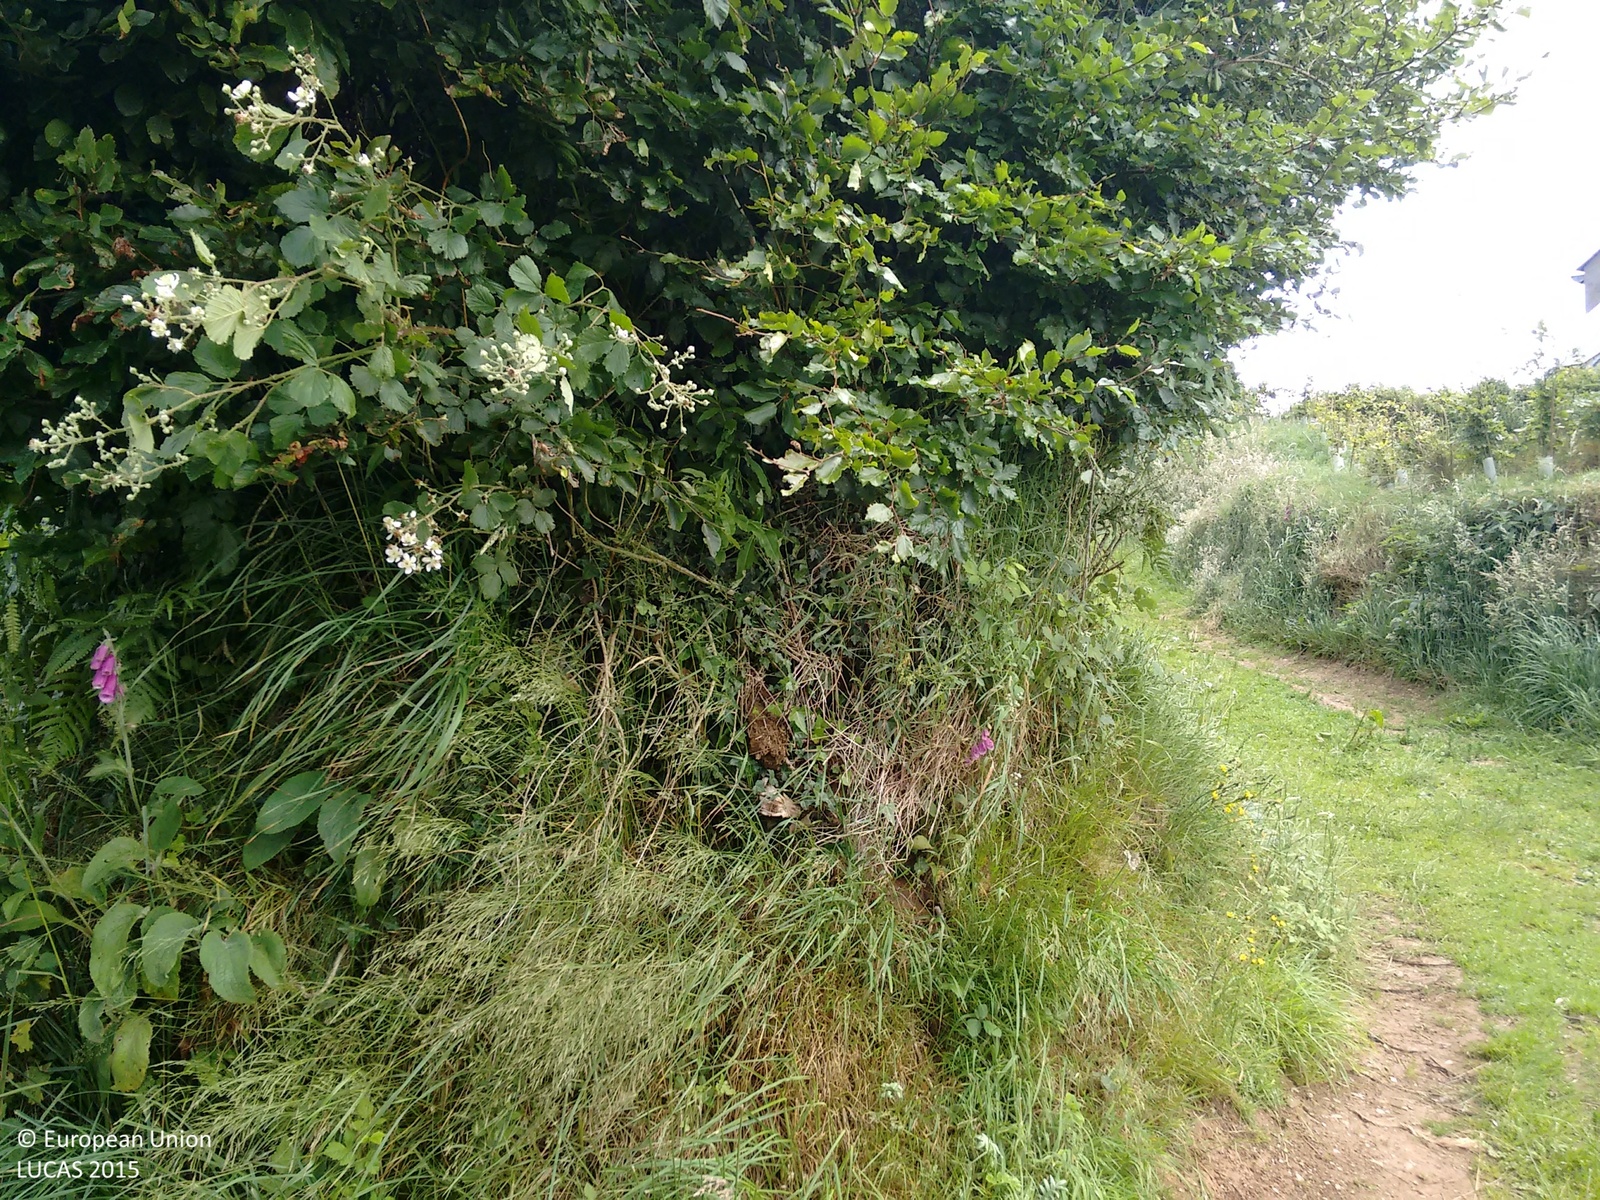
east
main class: Grassland
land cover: Grassland without tree/shrub cover
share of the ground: > 75 %
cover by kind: herbaceous plants 100 %
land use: Agriculture (excluding fallow land and kitchen gardens)
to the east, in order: Grassland without tree/shrub cover; Fences; Managed hedges; Grassland without tree/shrub cover; Artificial constructions in urban areas
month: July
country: GB
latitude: 51.1415
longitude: -3.5350
